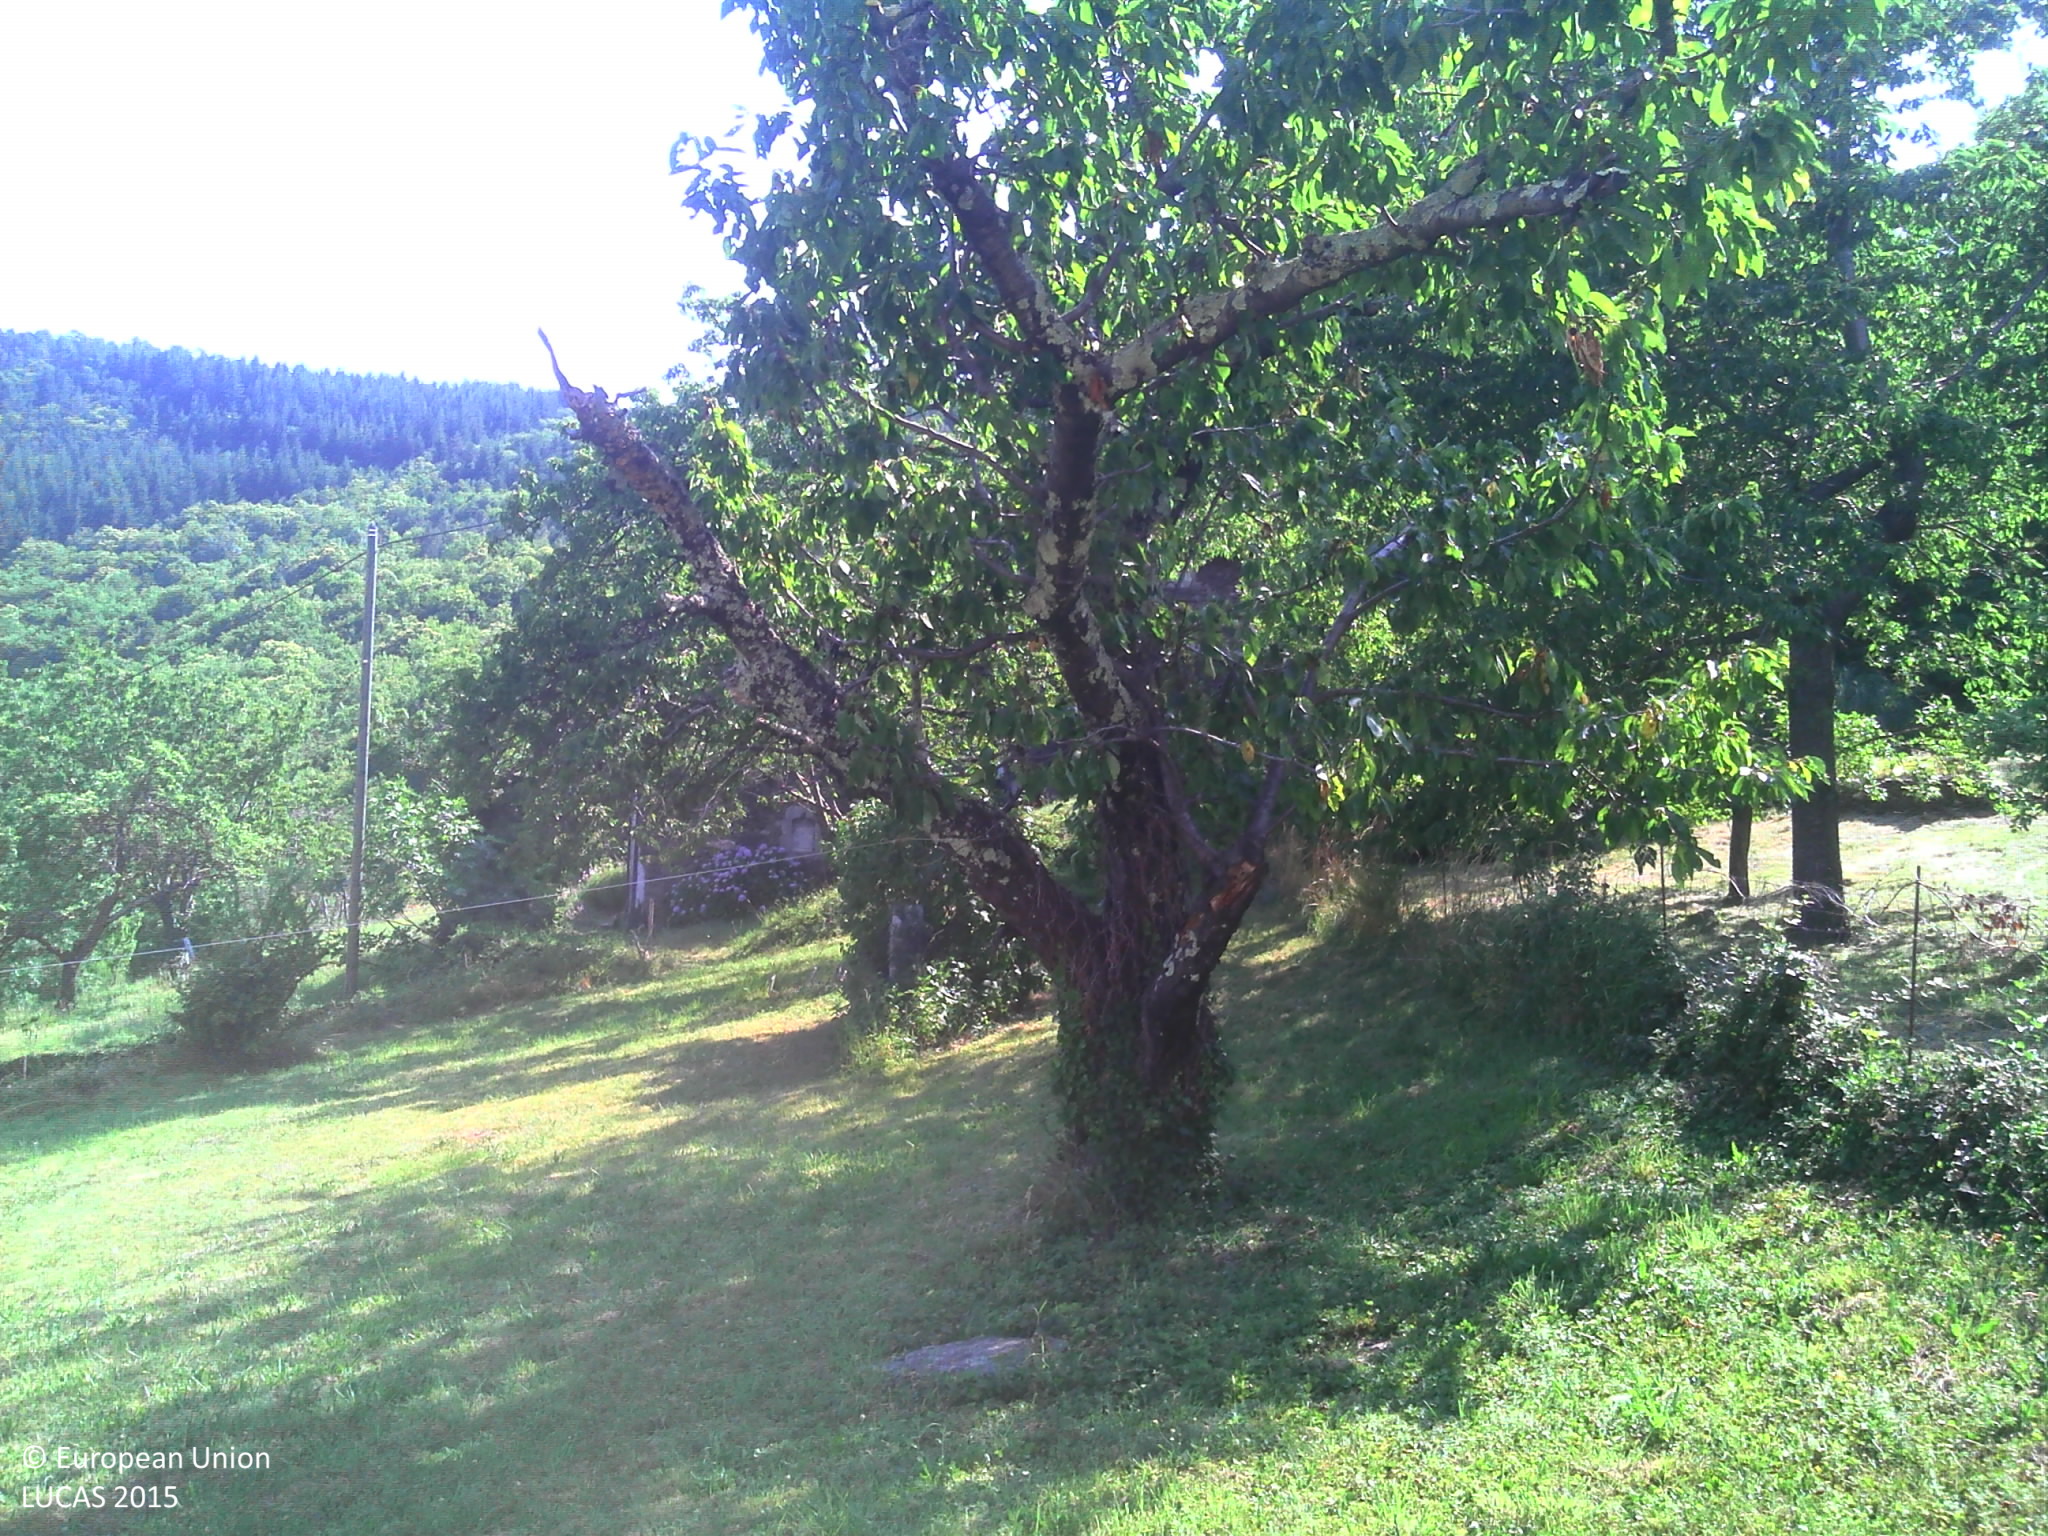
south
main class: Cropland
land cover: Cherry fruit
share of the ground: 25 - 50 %
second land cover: Grassland without tree/shrub cover
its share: 25 - 50 %
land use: Kitchen garden
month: July
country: FR
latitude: 44.2274
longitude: 3.9354
